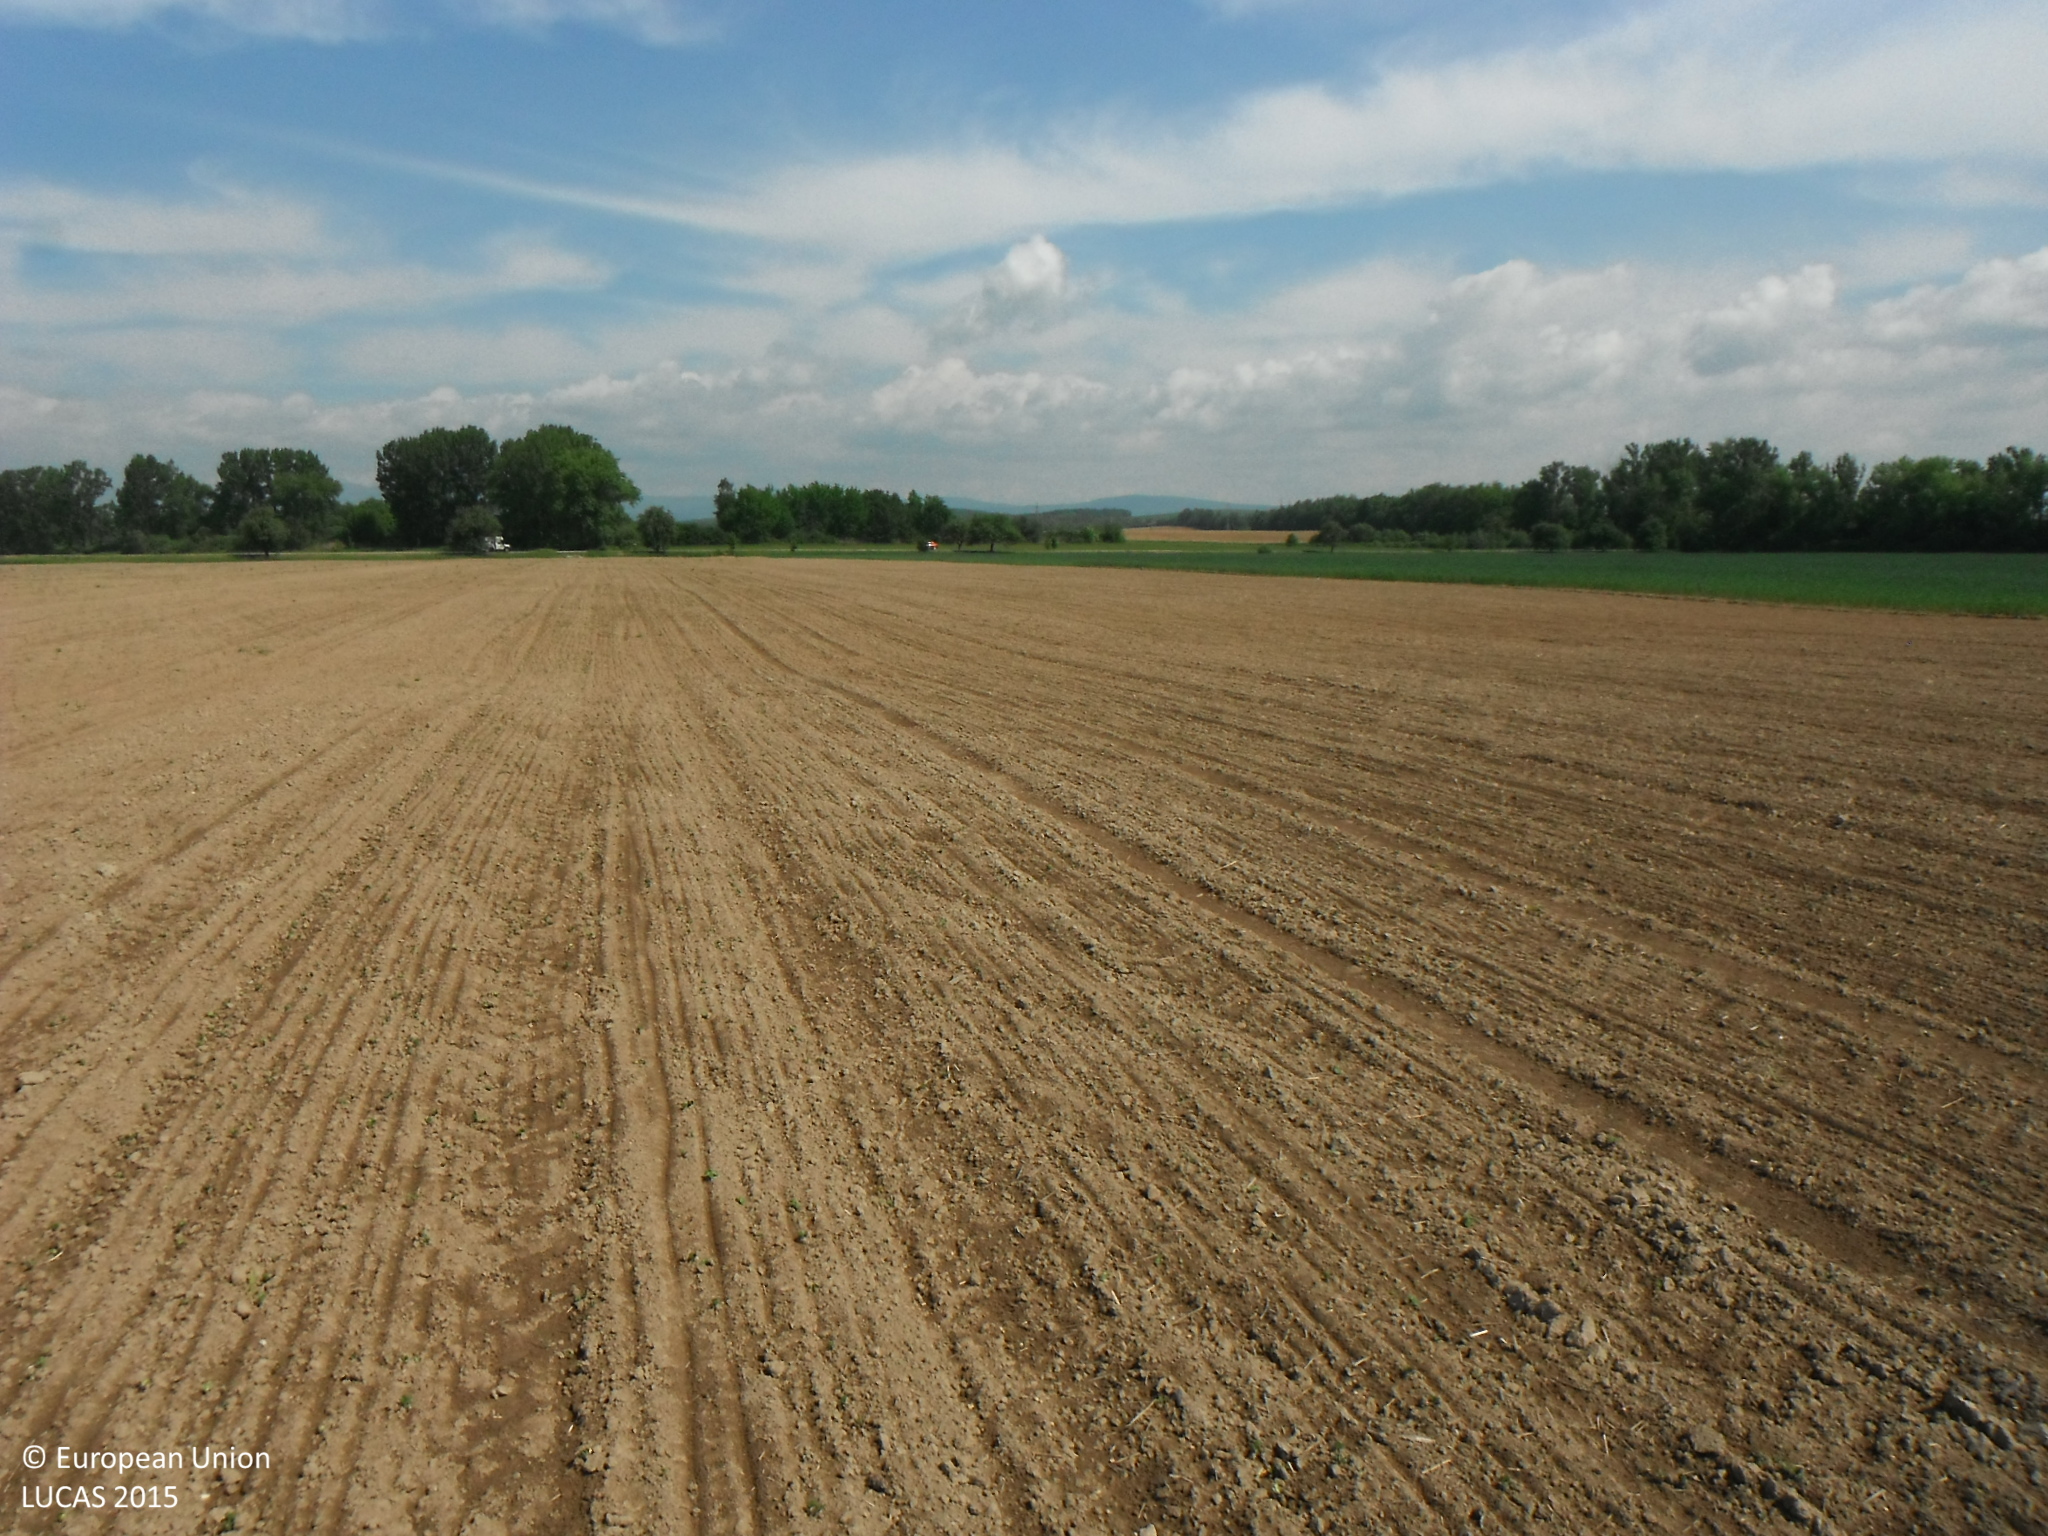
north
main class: Cropland
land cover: Soya
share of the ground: < 10 %
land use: Agriculture (excluding fallow land and kitchen gardens)
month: May
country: SK
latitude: 48.5936
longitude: 21.0375
